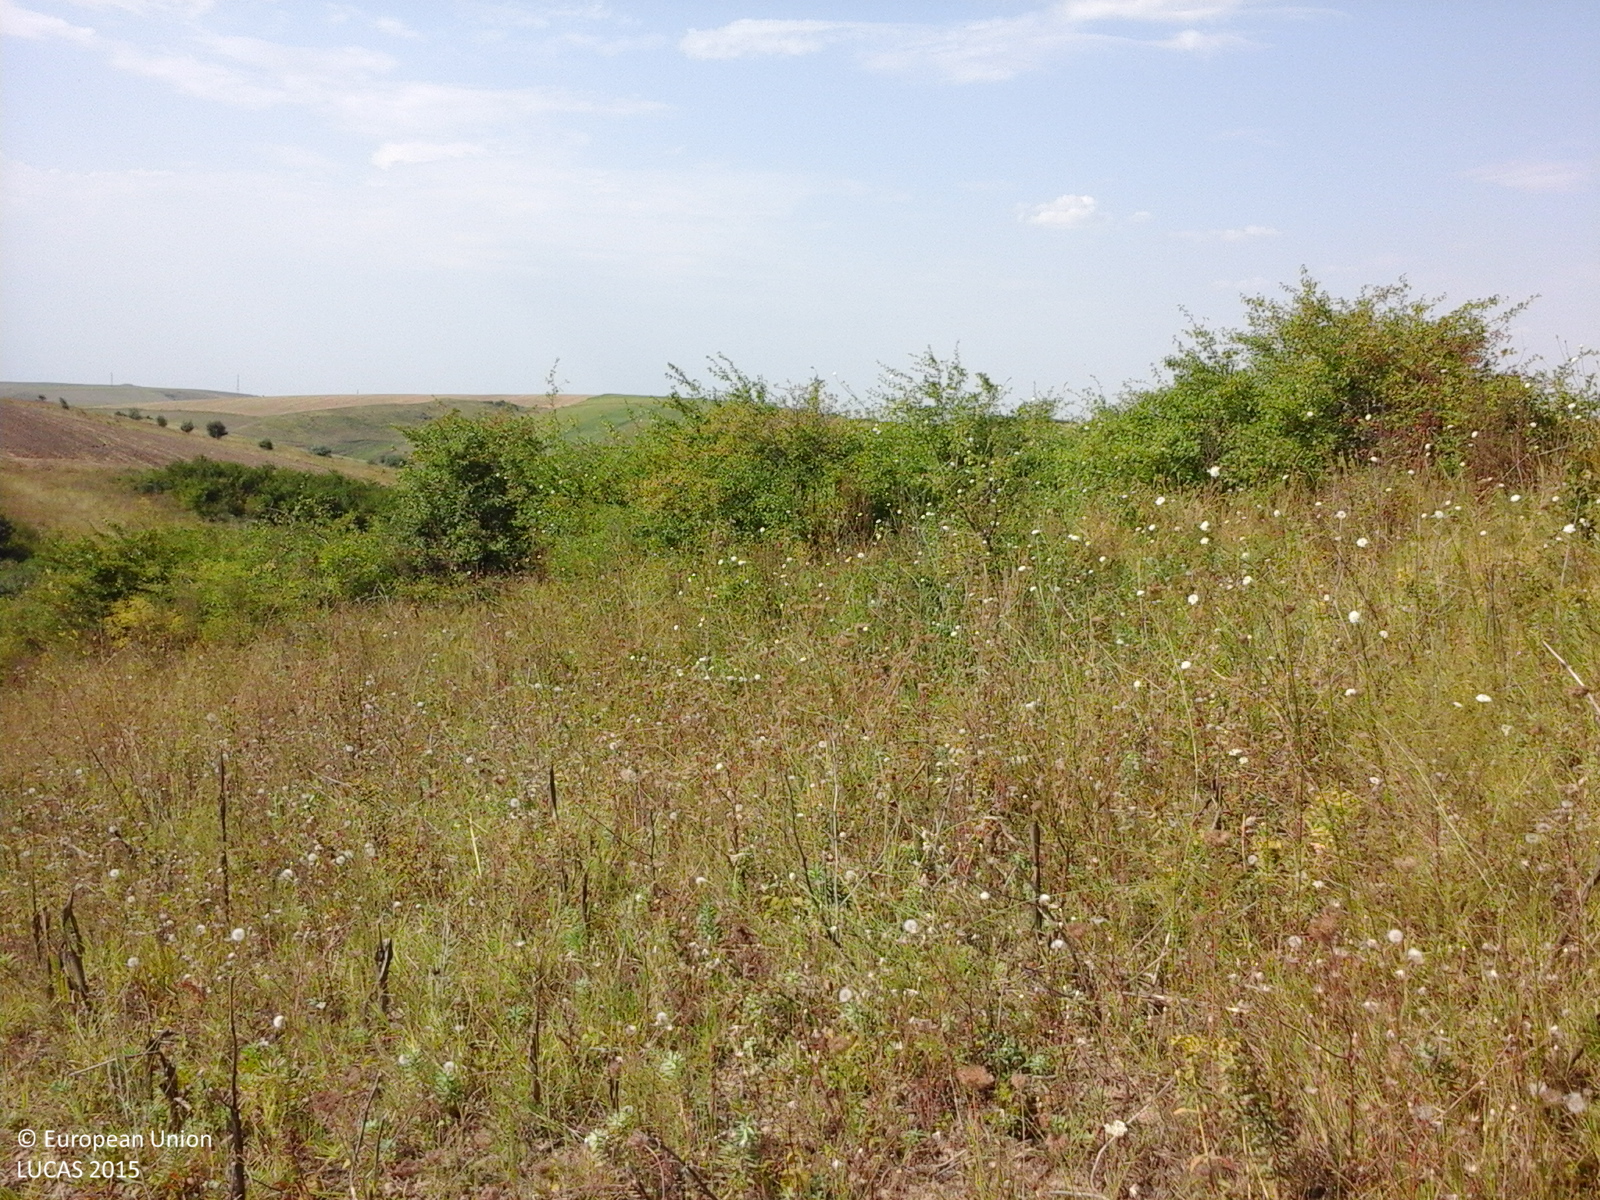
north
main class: Grassland
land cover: Spontaneously vegetated surfaces
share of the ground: 10 - 25 %
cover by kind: herbaceous plants 100 %
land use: Fallow land
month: August
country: RO
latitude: 44.1886
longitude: 27.9554
